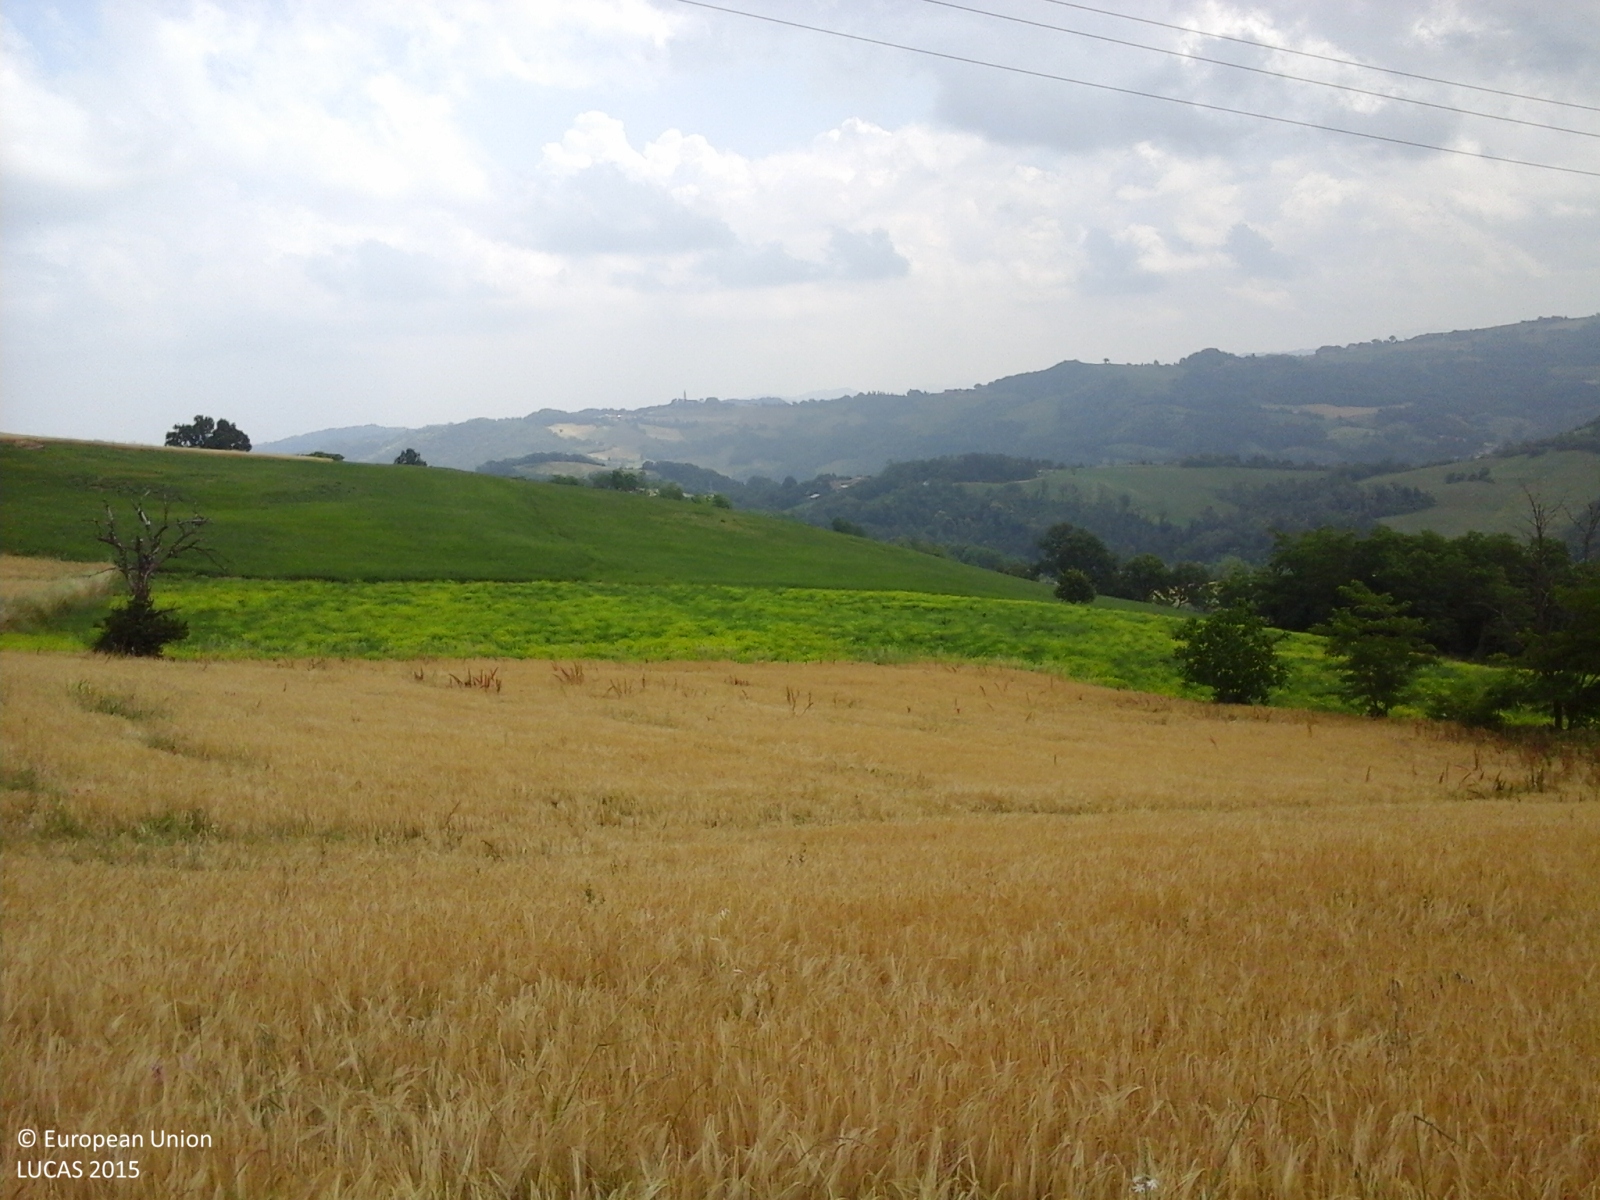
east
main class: Cropland
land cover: Barley
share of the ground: > 75 %
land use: Agriculture (excluding fallow land and kitchen gardens)
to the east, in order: Barley; Electric lines; Barley; Spontaneously vegetated surfaces; Lucerne
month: June
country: IT
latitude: 44.8369
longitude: 9.6592
